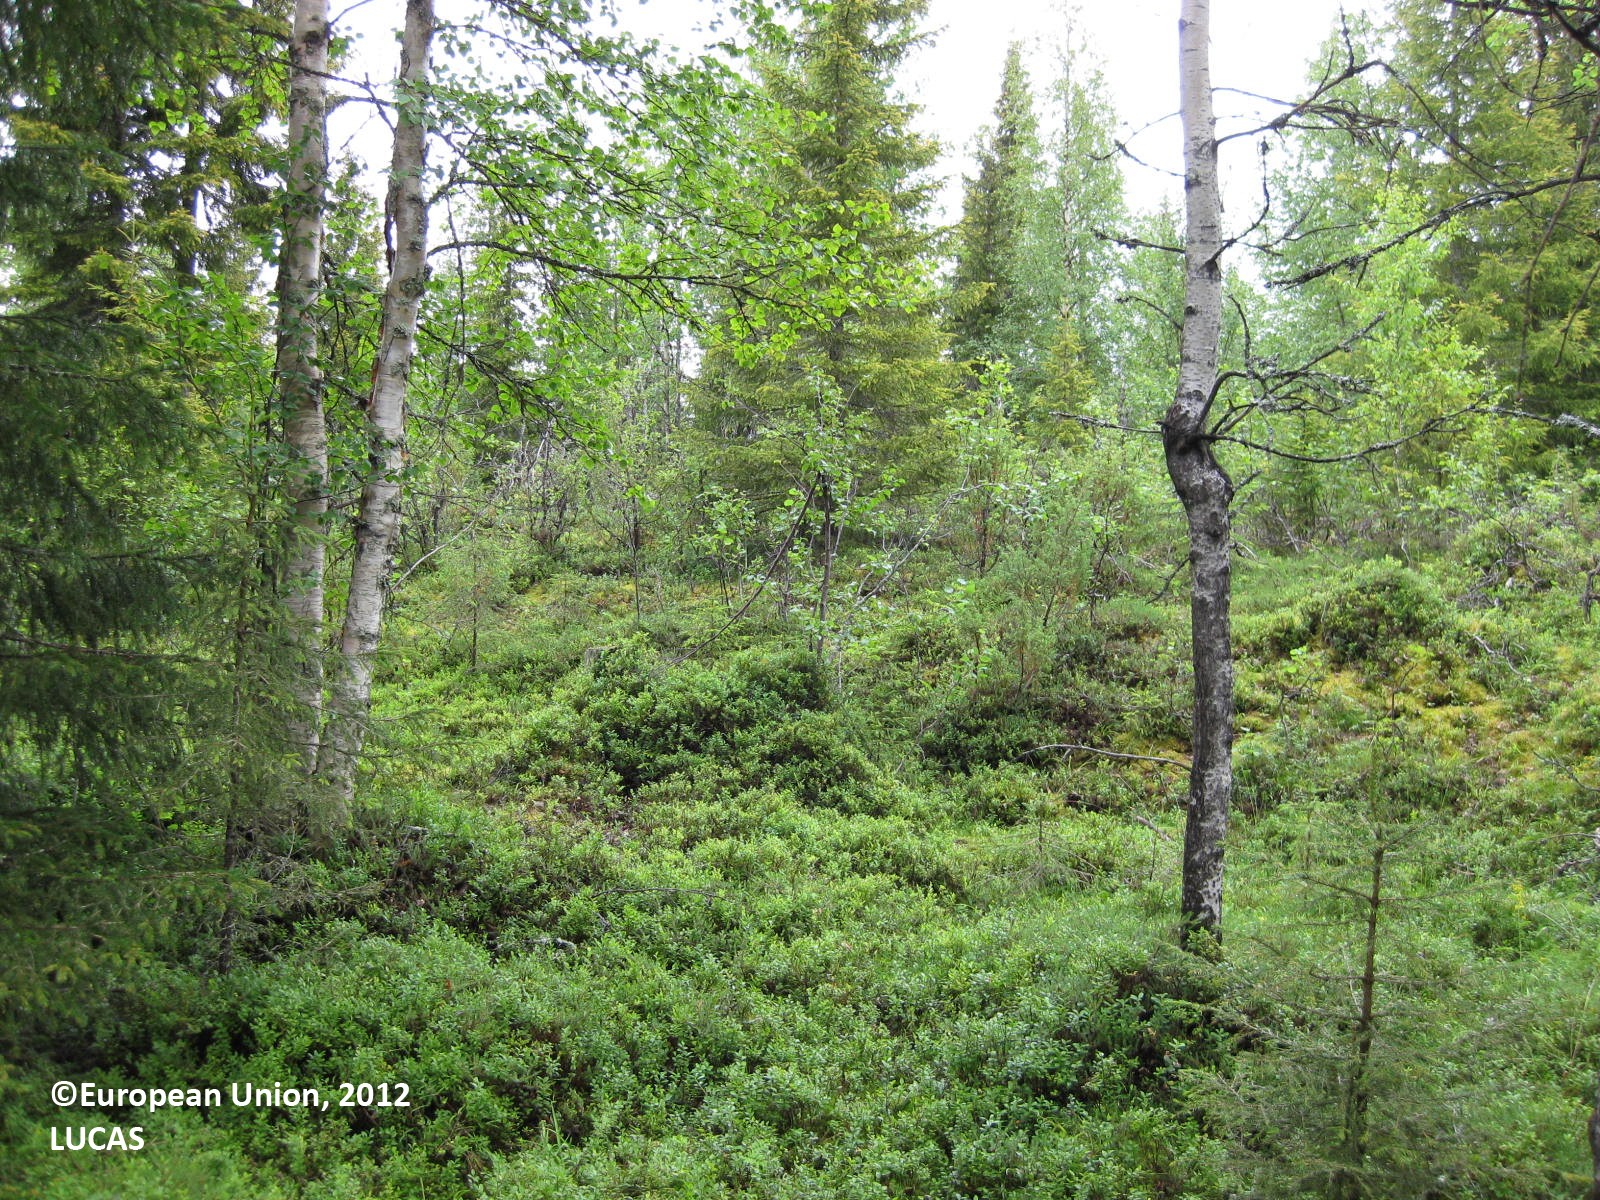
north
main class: Woodland
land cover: Spruce dominated mixed woodland
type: boreal forest
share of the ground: 50 - 75 %
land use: Forestry
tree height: > 5 m
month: July
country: FI
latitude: 65.8735
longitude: 28.5071
